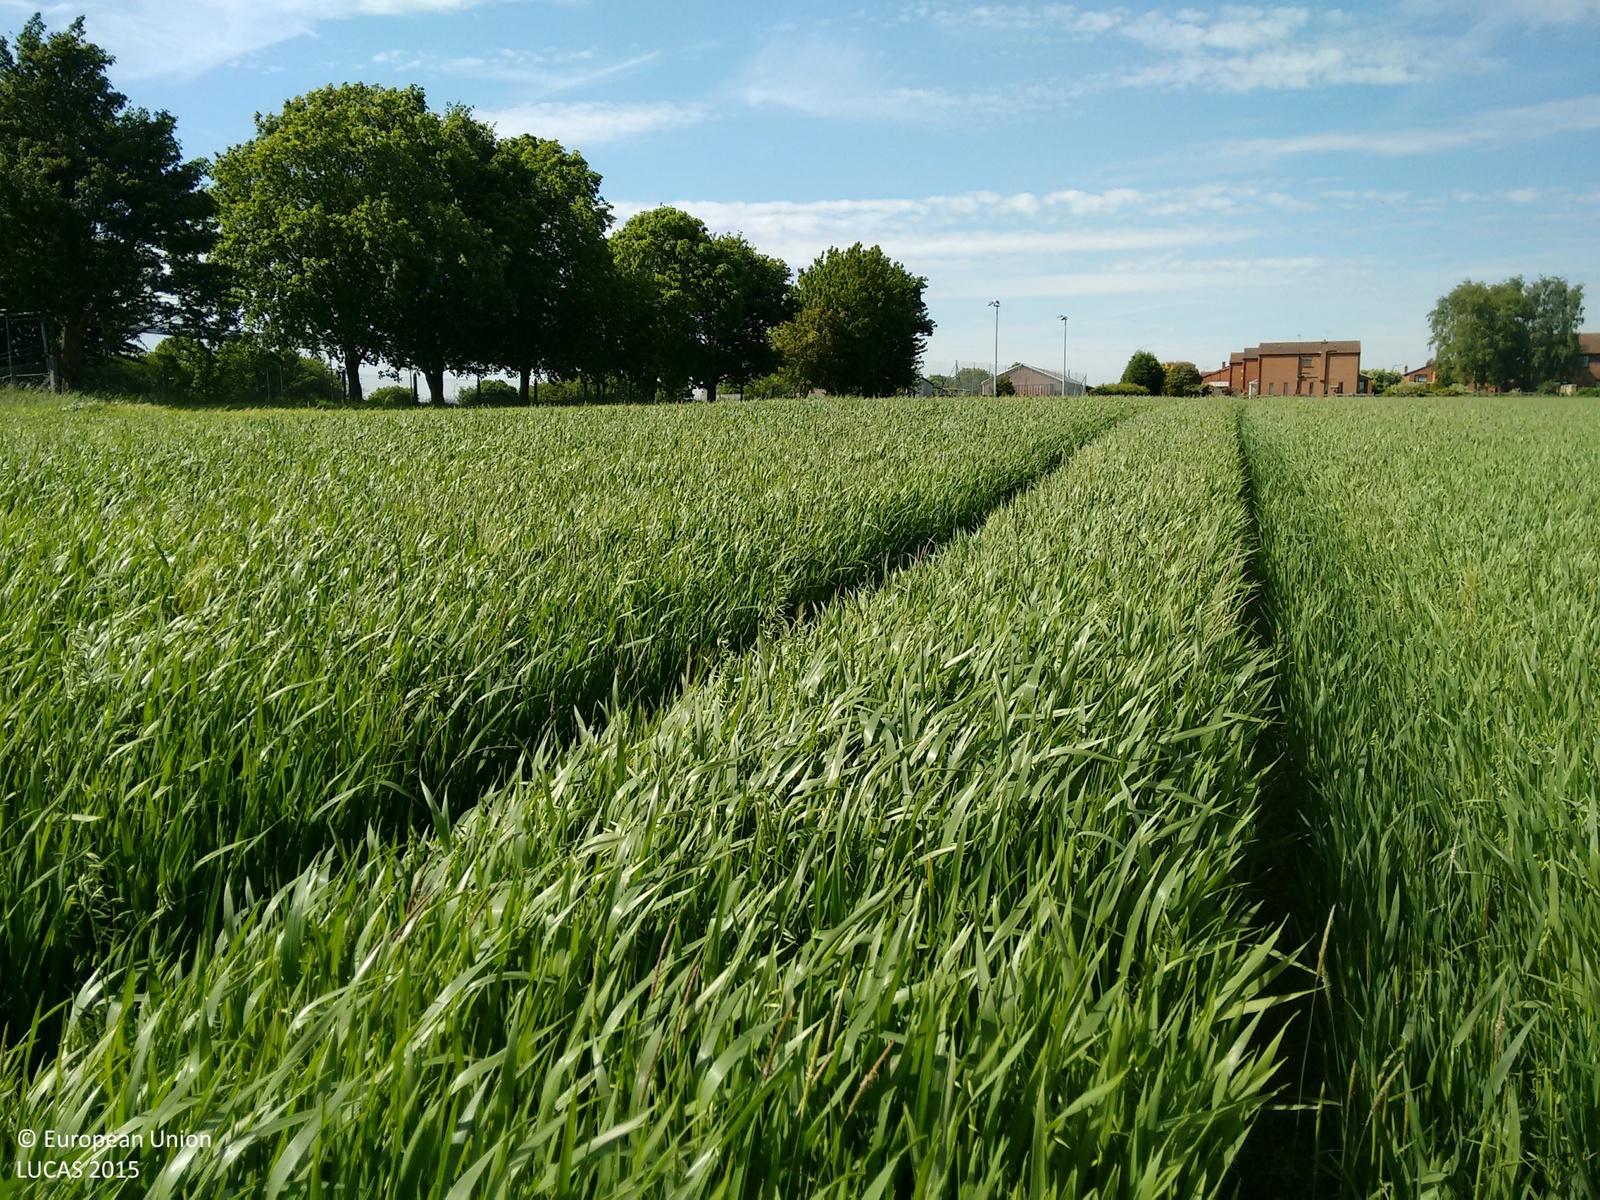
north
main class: Cropland
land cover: Oats
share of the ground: > 75 %
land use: Agriculture (excluding fallow land and kitchen gardens)
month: June
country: GB
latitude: 52.4827
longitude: -1.3727
